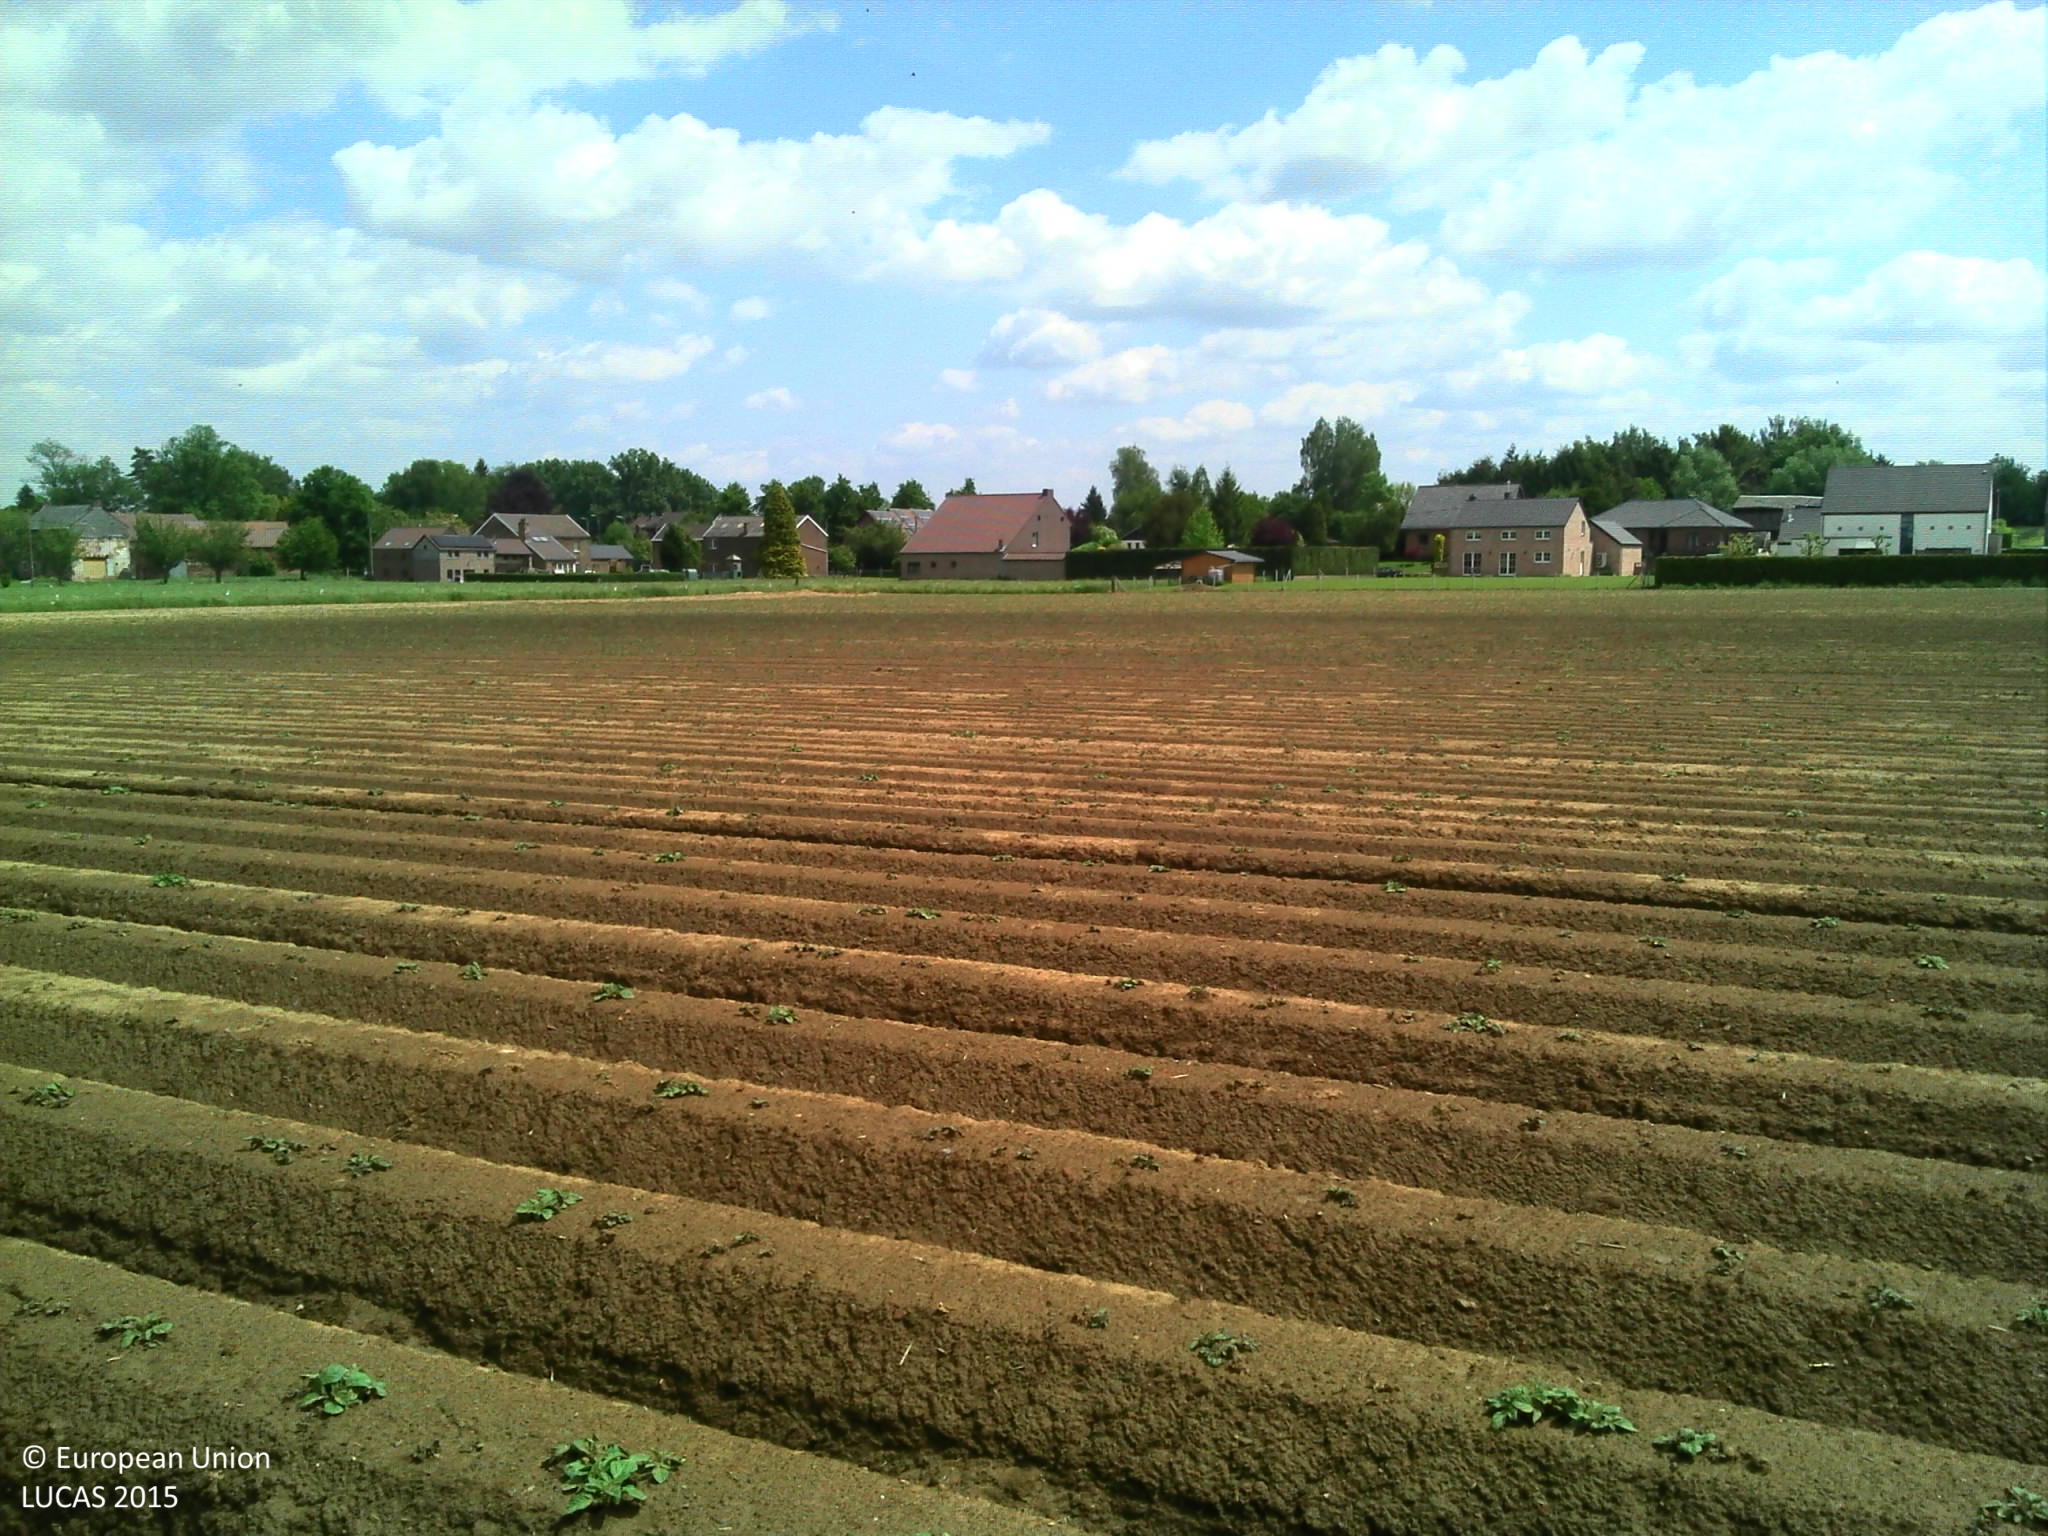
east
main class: Cropland
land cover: Potatoes
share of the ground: < 10 %
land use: Agriculture (excluding fallow land and kitchen gardens)
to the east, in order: Potatoes; Grass margins; Fences; Grassland without tree/shrub cover; Artificial constructions in urban areas
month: May
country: BE
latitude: 50.6585
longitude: 5.1738
